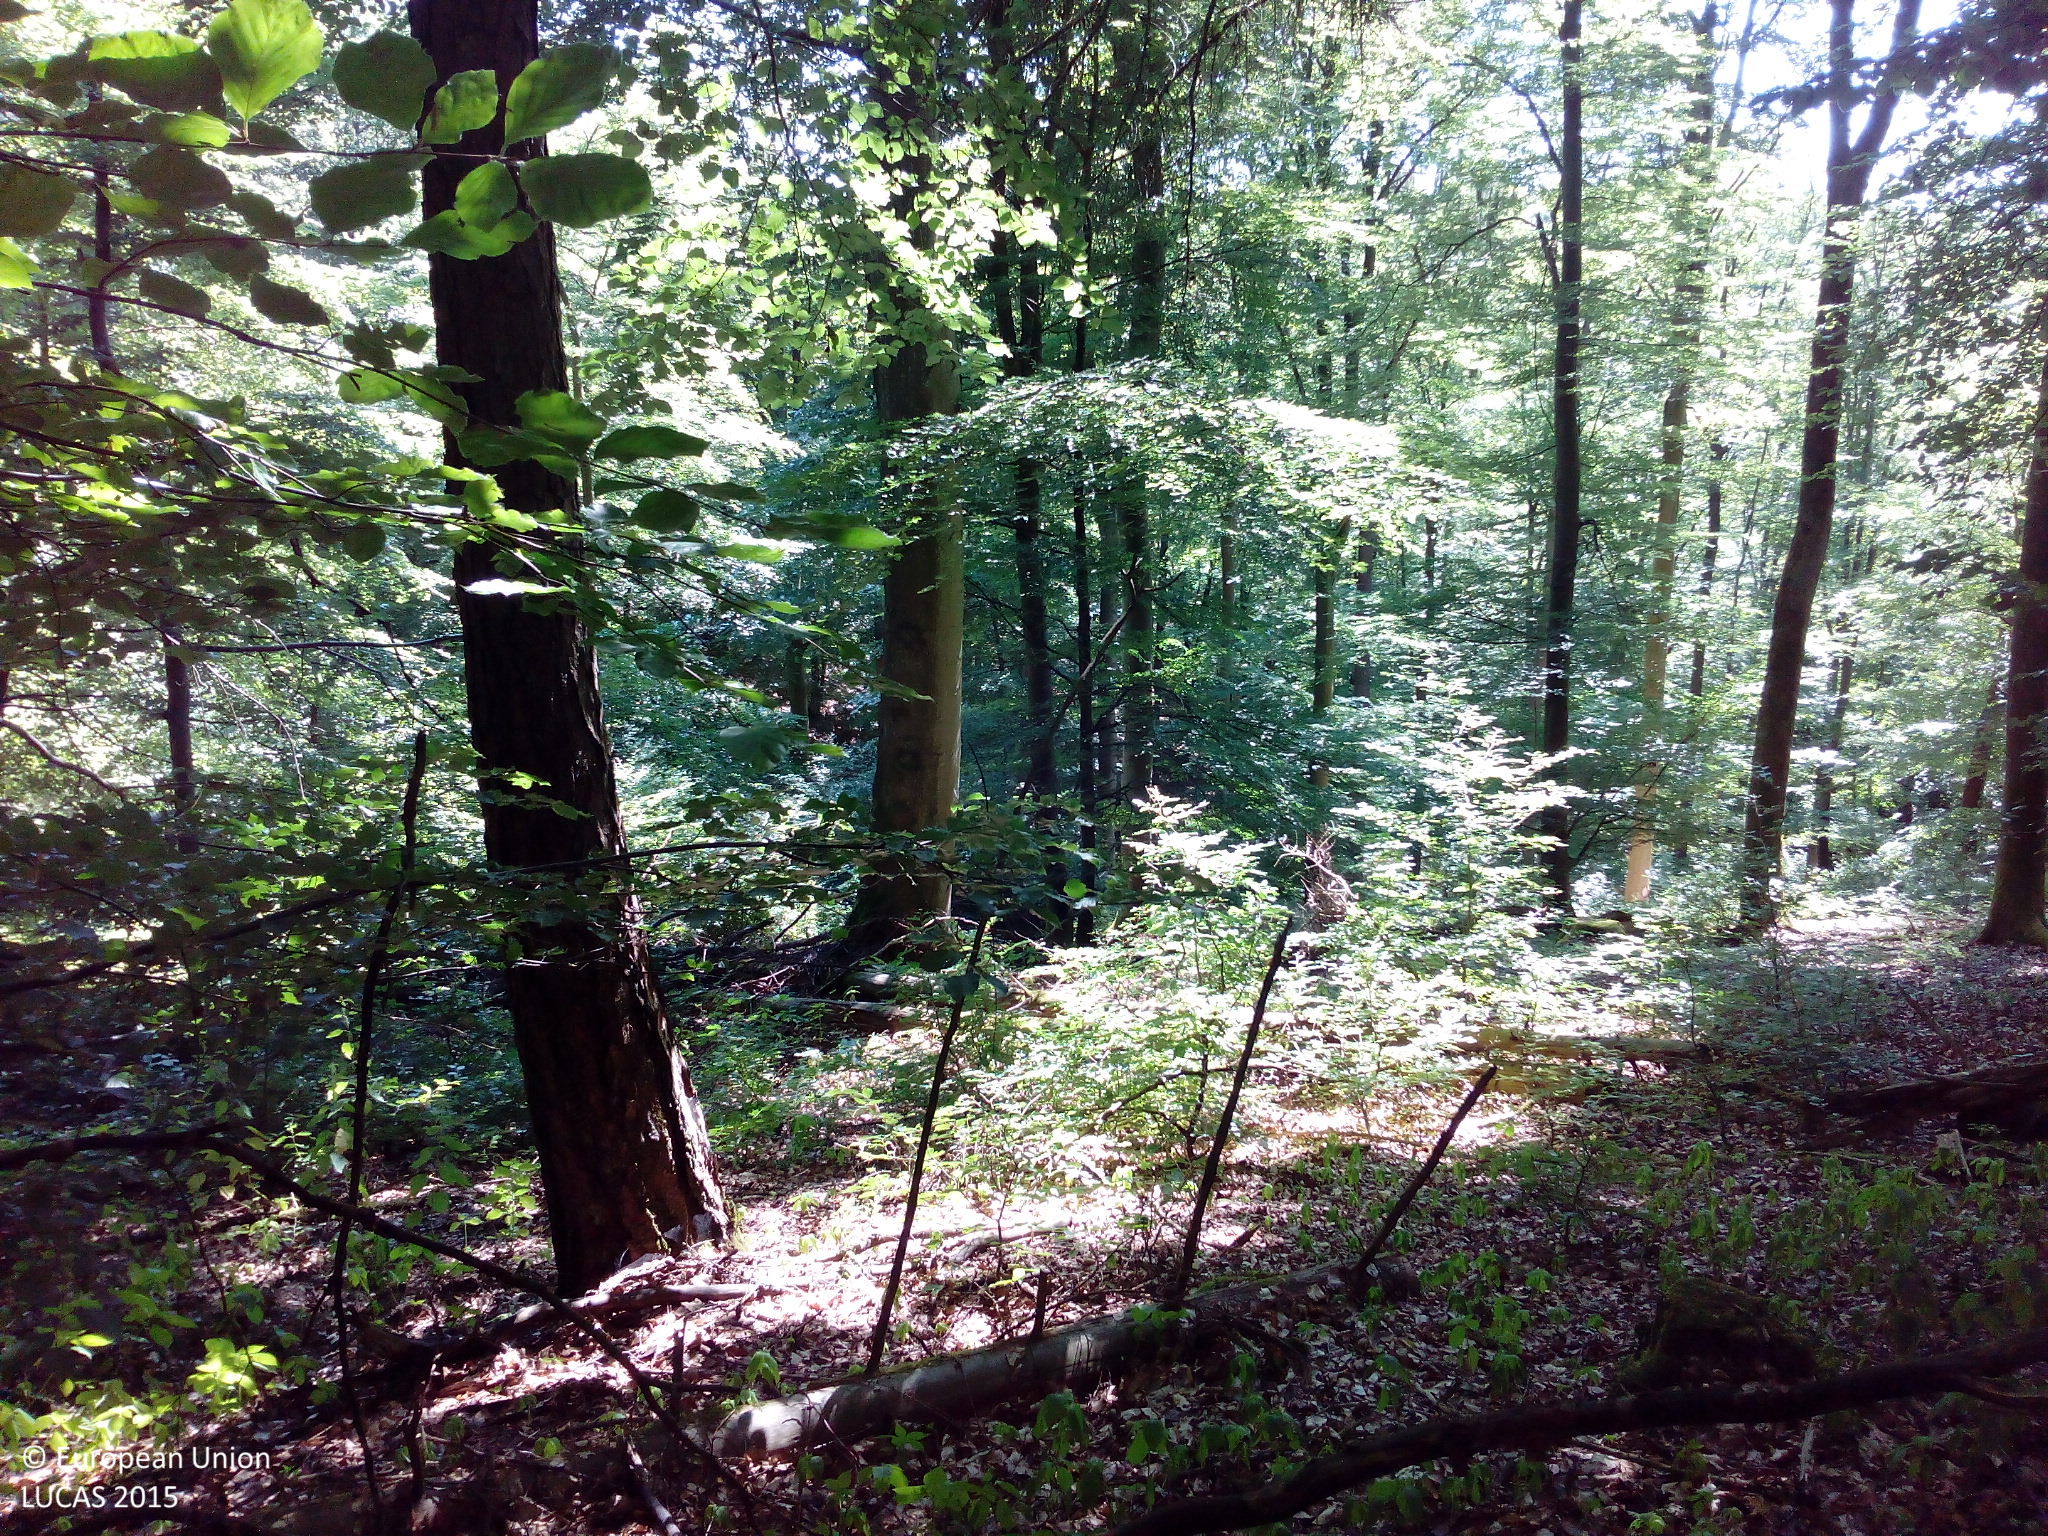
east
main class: Woodland
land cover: Spruce dominated mixed woodland
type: mesophytic deciduous forest
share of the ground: > 75 %
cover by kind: broadleaved forest trees 55 %, coniferous forest trees 30 %, herbaceous plants 10 %, unconsolidated bare surface 5 %
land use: Forestry
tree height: > 5 m
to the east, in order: Spruce dominated mixed woodland; Broadleaved woodland; Tracks; Broadleaved woodland; Rivers and streams; Broadleaved woodland; Tracks; Broadleaved woodland; Tracks; Shruby margins; Grassland without tree/shrub cover; Rivers and streams; Shrubland without tree cover; Grass margins; Spruce dominated mixed woodland; Spruce dominated coniferous woodland
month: July
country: DE
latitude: 50.1133
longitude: 8.0286
